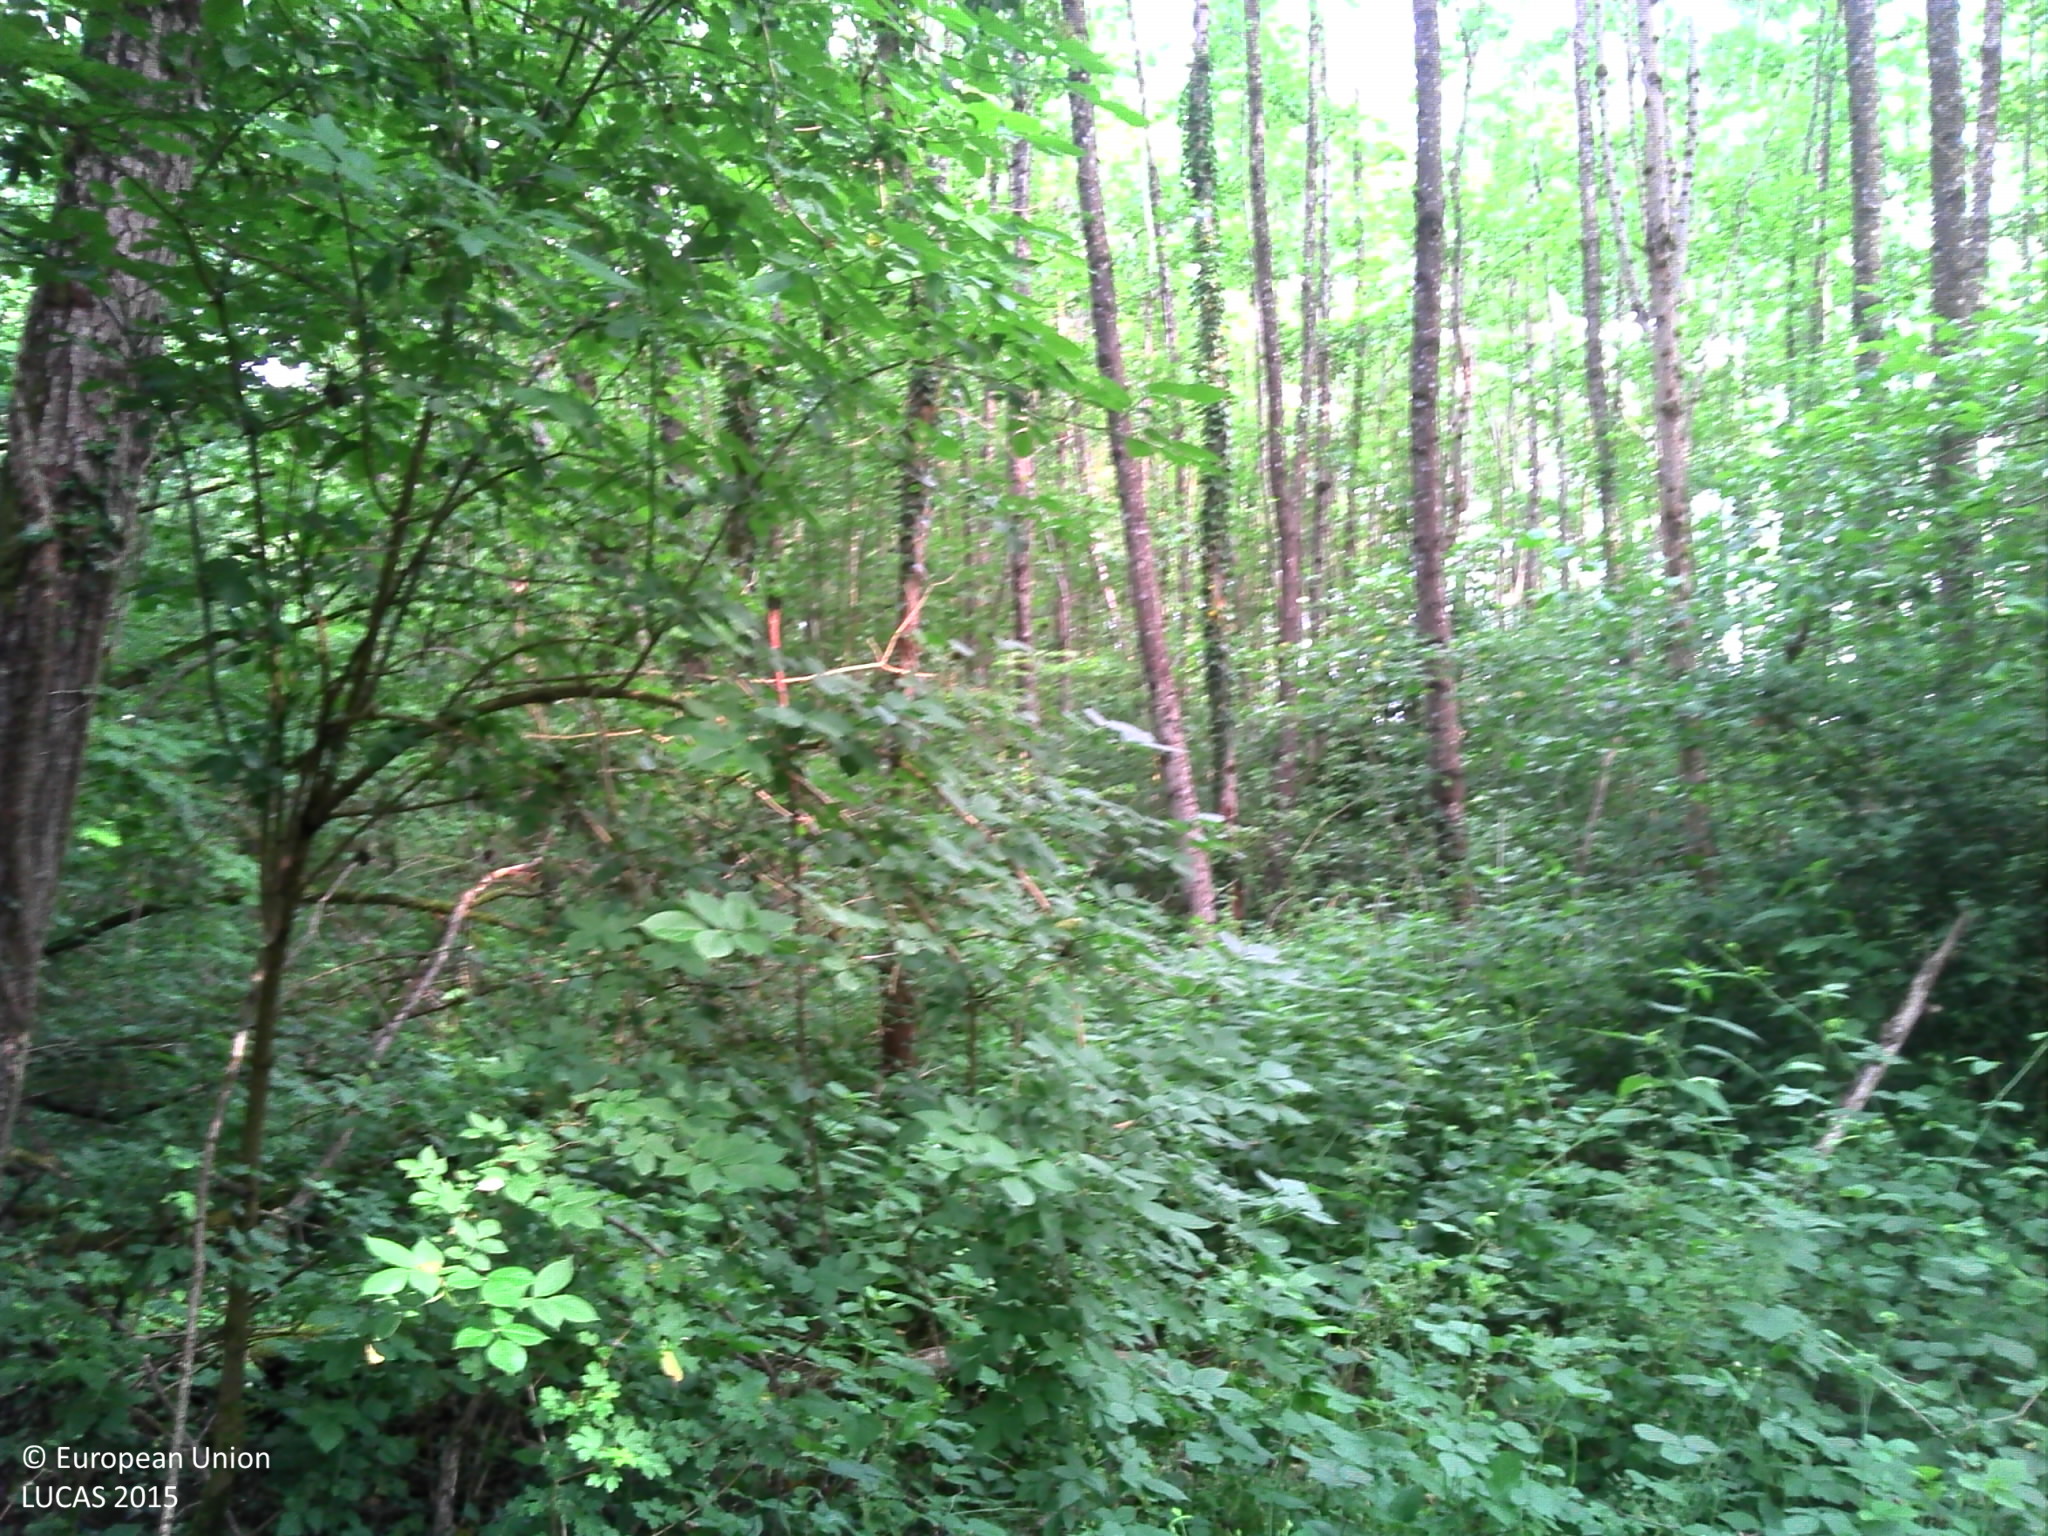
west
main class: Woodland
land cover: Broadleaved woodland
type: beech forest
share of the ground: > 75 %
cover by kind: broadleaved forest trees 90 %, herbaceous plants 10 %
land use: Forestry
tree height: > 5 m
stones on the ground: < 10 %
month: June
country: FR
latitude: 47.7114
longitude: 6.3092
